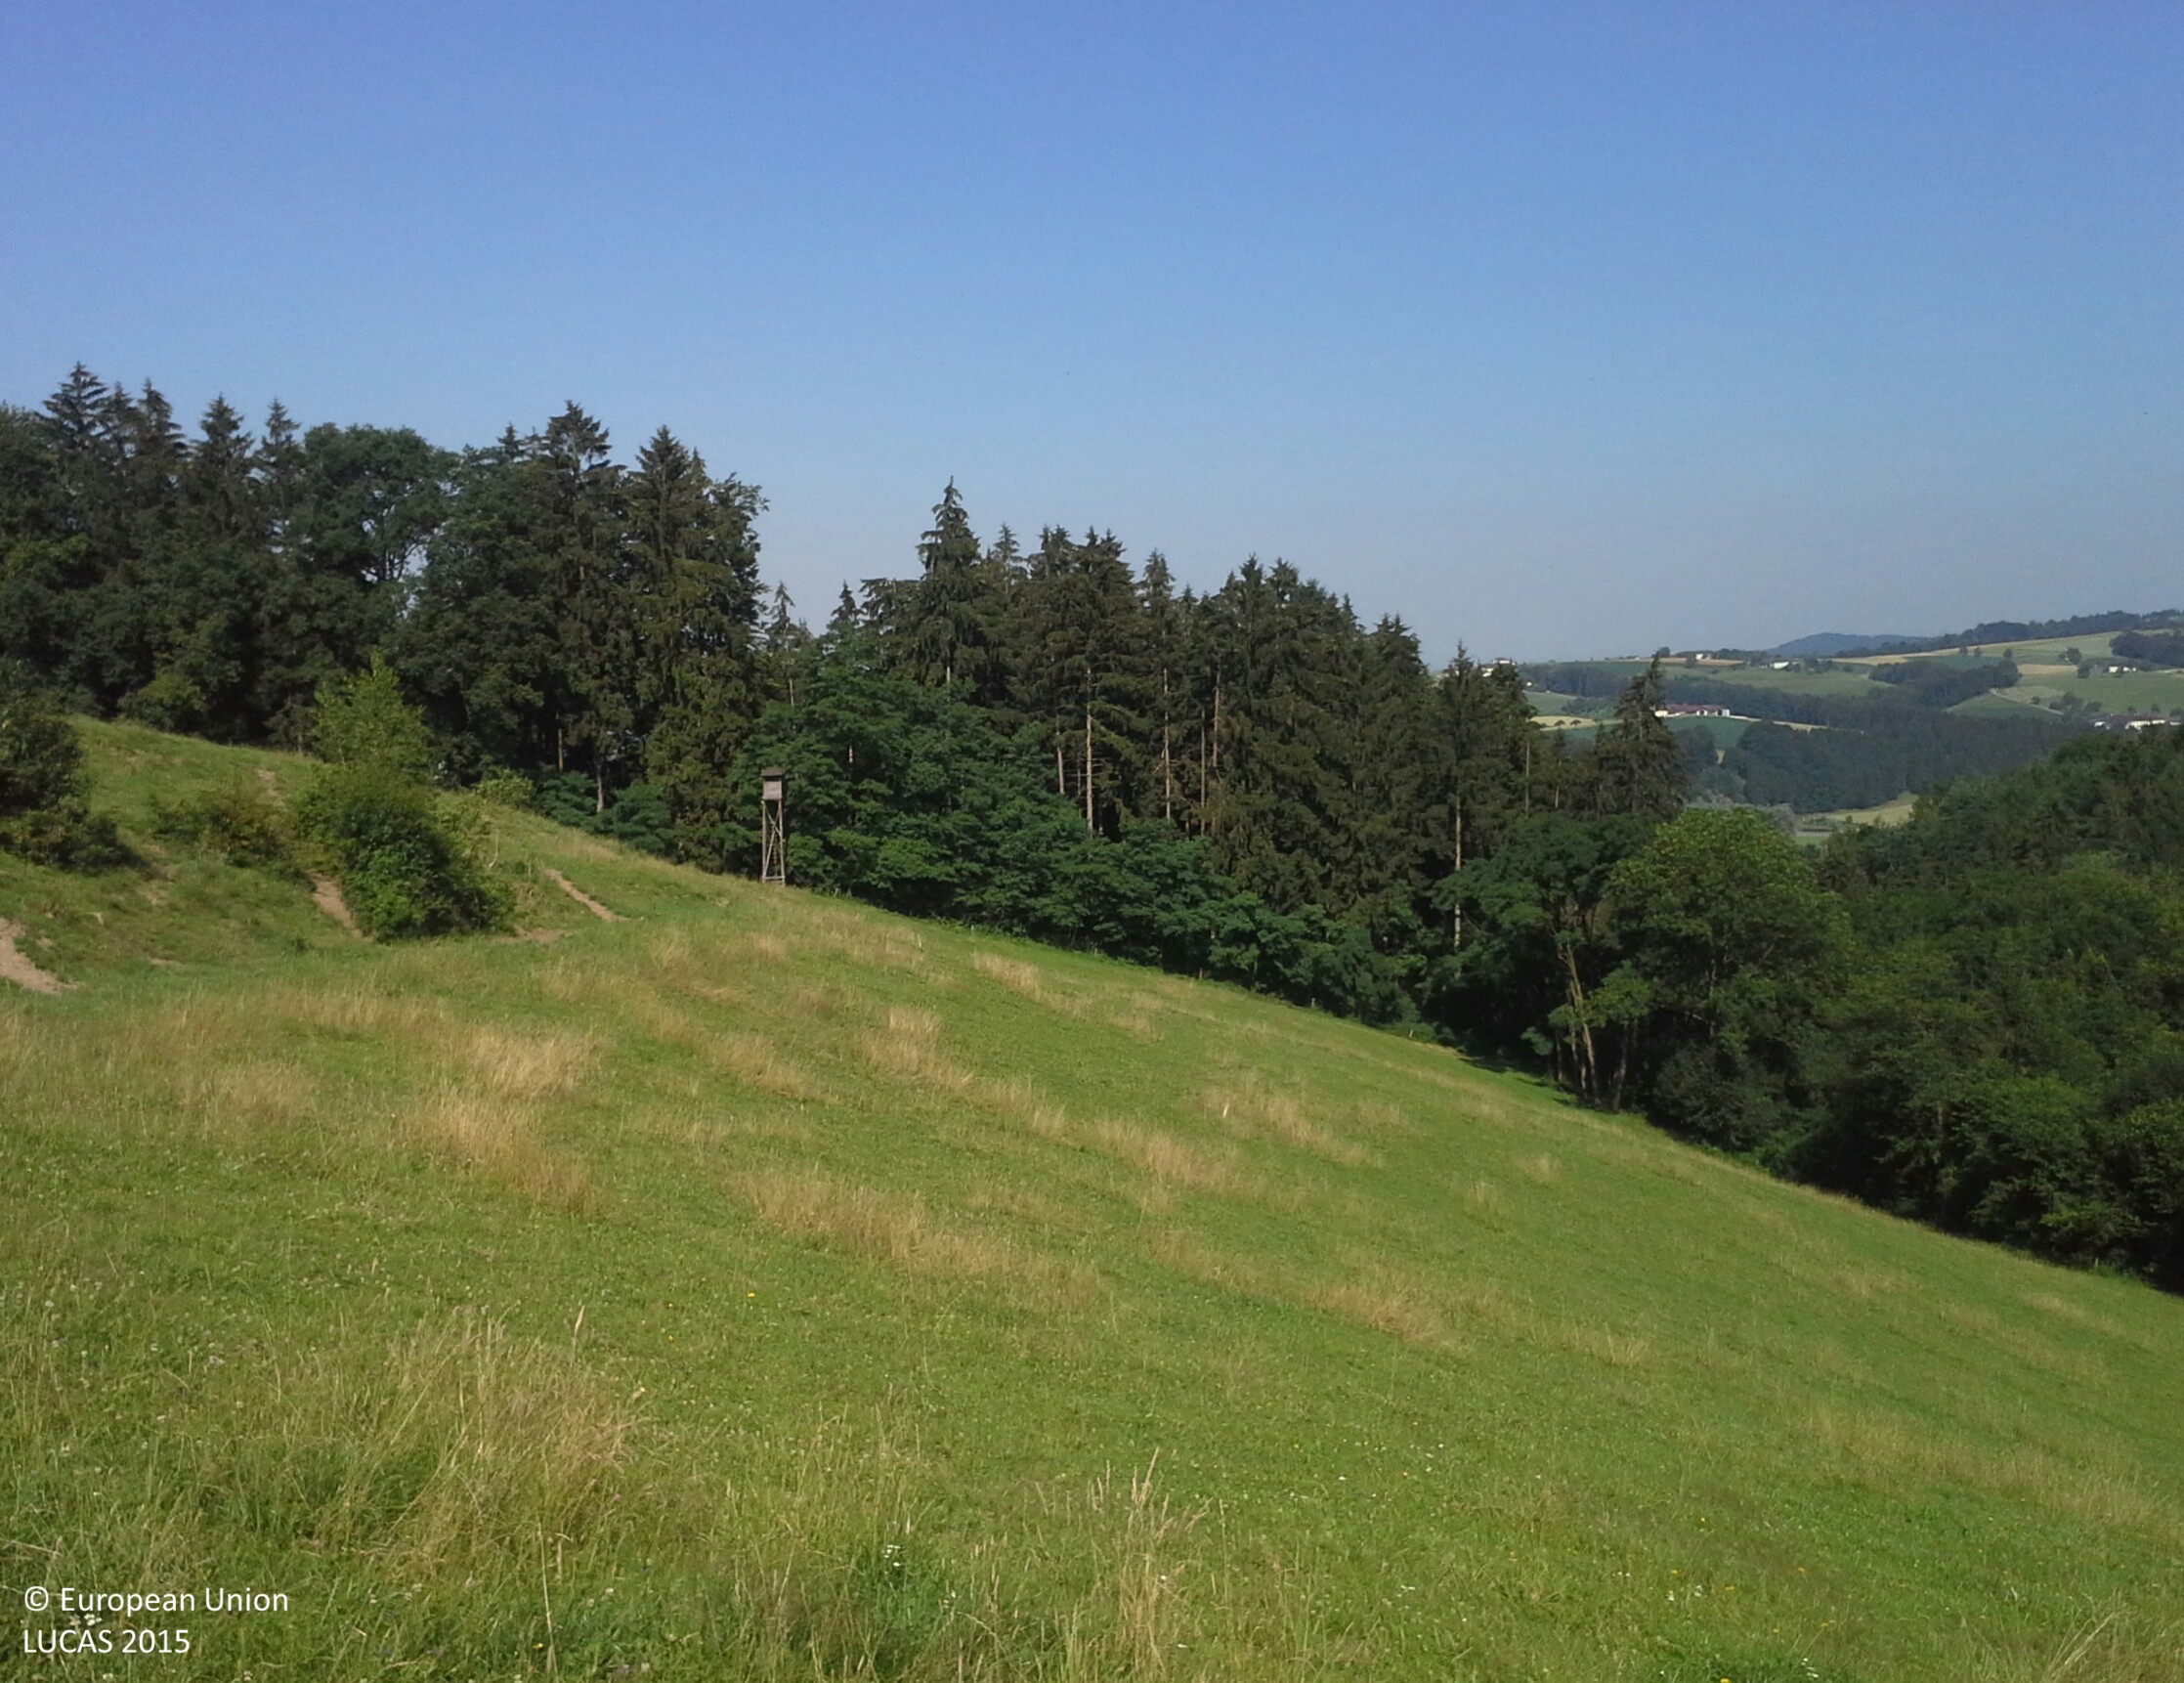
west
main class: Grassland
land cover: Grassland without tree/shrub cover
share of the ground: > 75 %
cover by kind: herbaceous plants 100 %
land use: Agriculture (excluding fallow land and kitchen gardens)
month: July
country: AT
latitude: 48.1887
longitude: 14.8569
